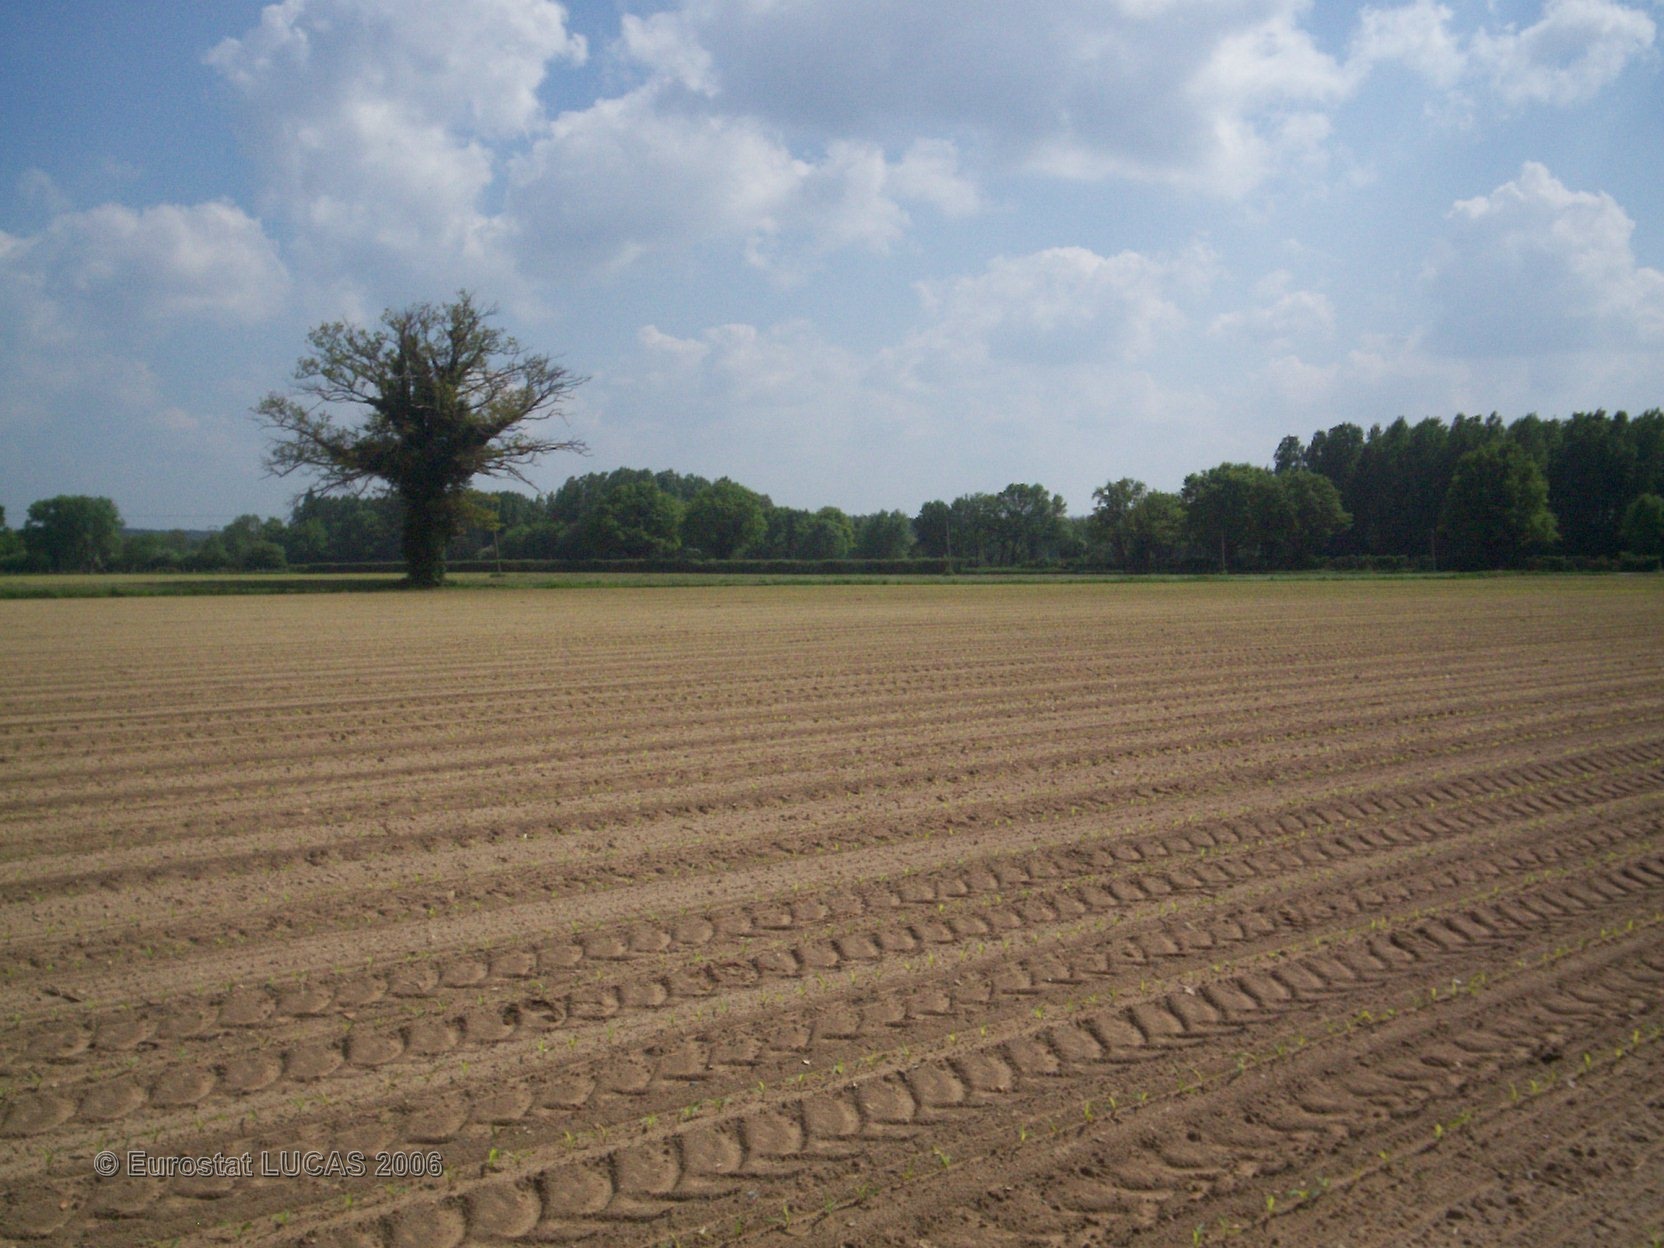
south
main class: Cropland
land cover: Maize
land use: Agriculture (excluding fallow land and kitchen gardens)
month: May
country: FR
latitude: 47.6402
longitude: 0.1920
